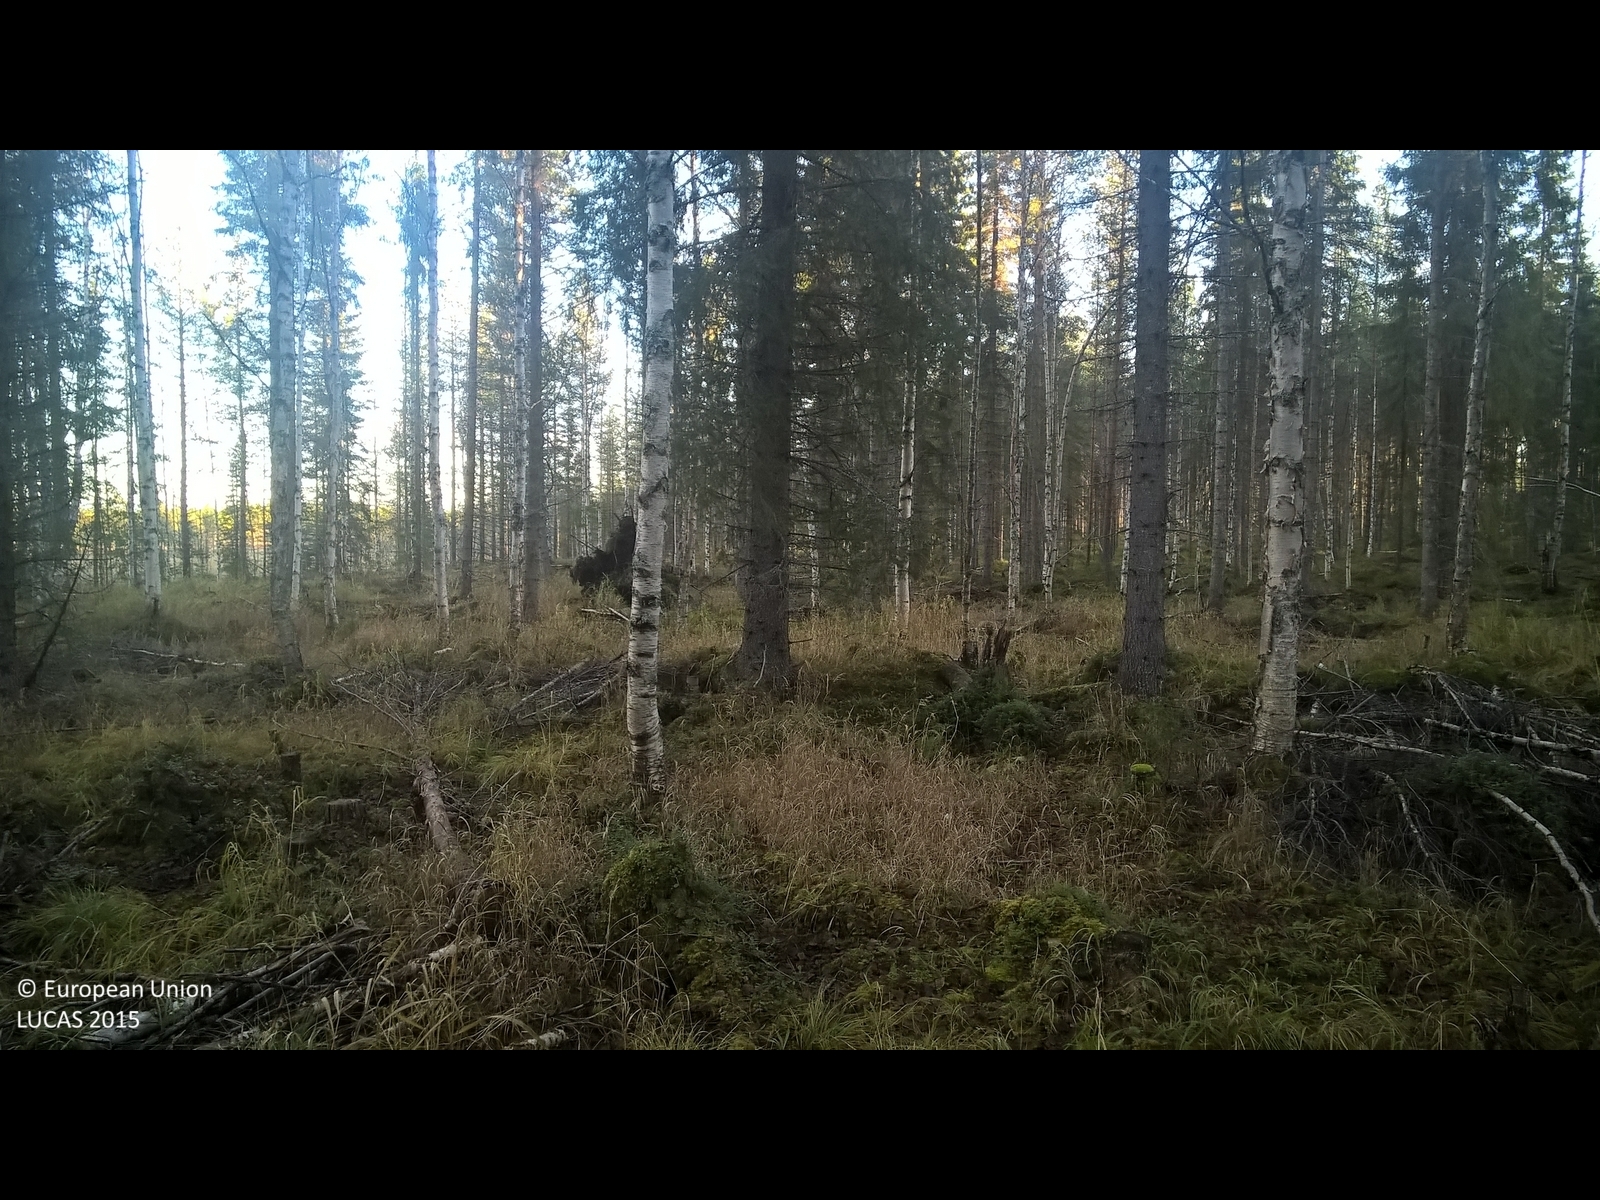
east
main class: Woodland
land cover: Spruce dominated mixed woodland
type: mire and swamp forests
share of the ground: 50 - 75 %
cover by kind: coniferous forest trees 50 %, broadleaved forest trees 25 %, herbaceous plants 15 %, shrubs 5 %, lichens and mosses 5 %
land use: Forestry
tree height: > 5 m
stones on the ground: < 10 %
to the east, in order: Spruce dominated mixed woodland; Ditches and canals; Spruce dominated mixed woodland; Peatbogs
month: October
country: SE
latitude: 65.2453
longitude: 18.4592
